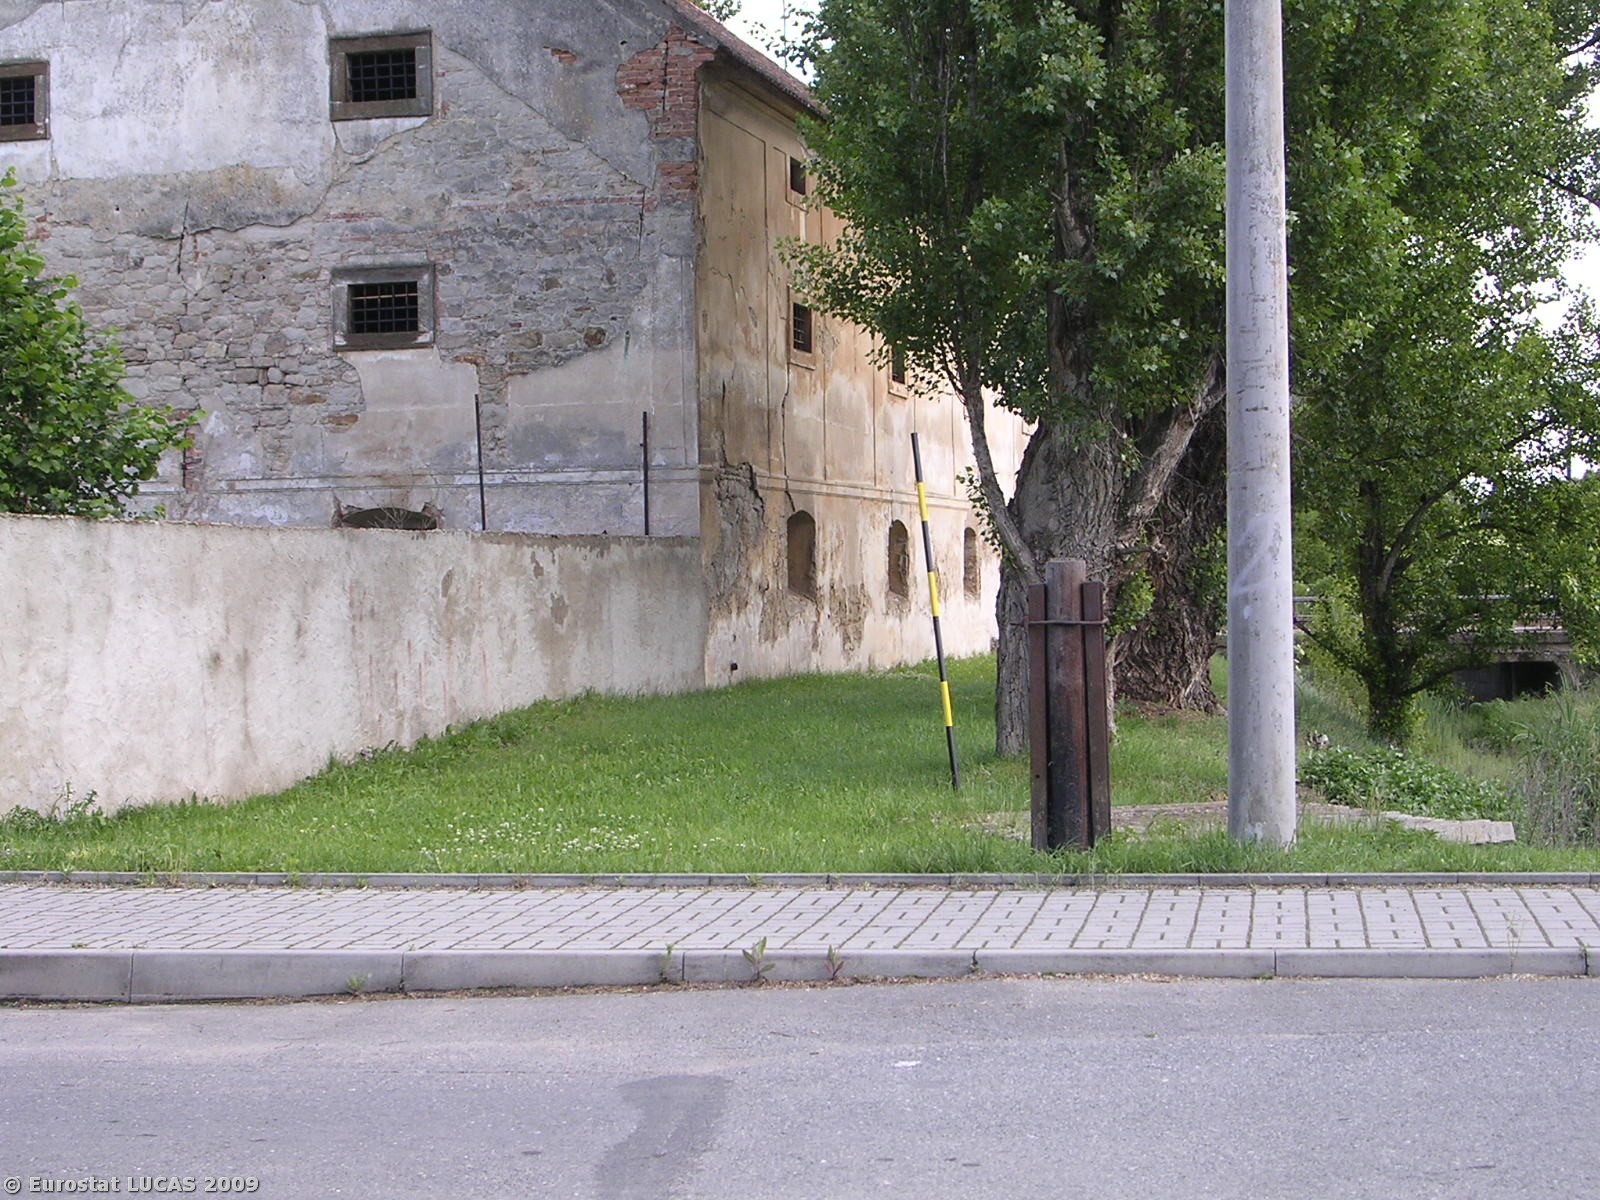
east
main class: Grassland
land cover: Grassland without tree/shrub cover
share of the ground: > 75 %
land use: Unused
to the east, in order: Grassland without tree/shrub cover; Other structural elements; Paved roads, cycling and walking lanes; Artificial constructions in urban areas
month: May
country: CZ
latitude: 50.3060
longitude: 14.1713
